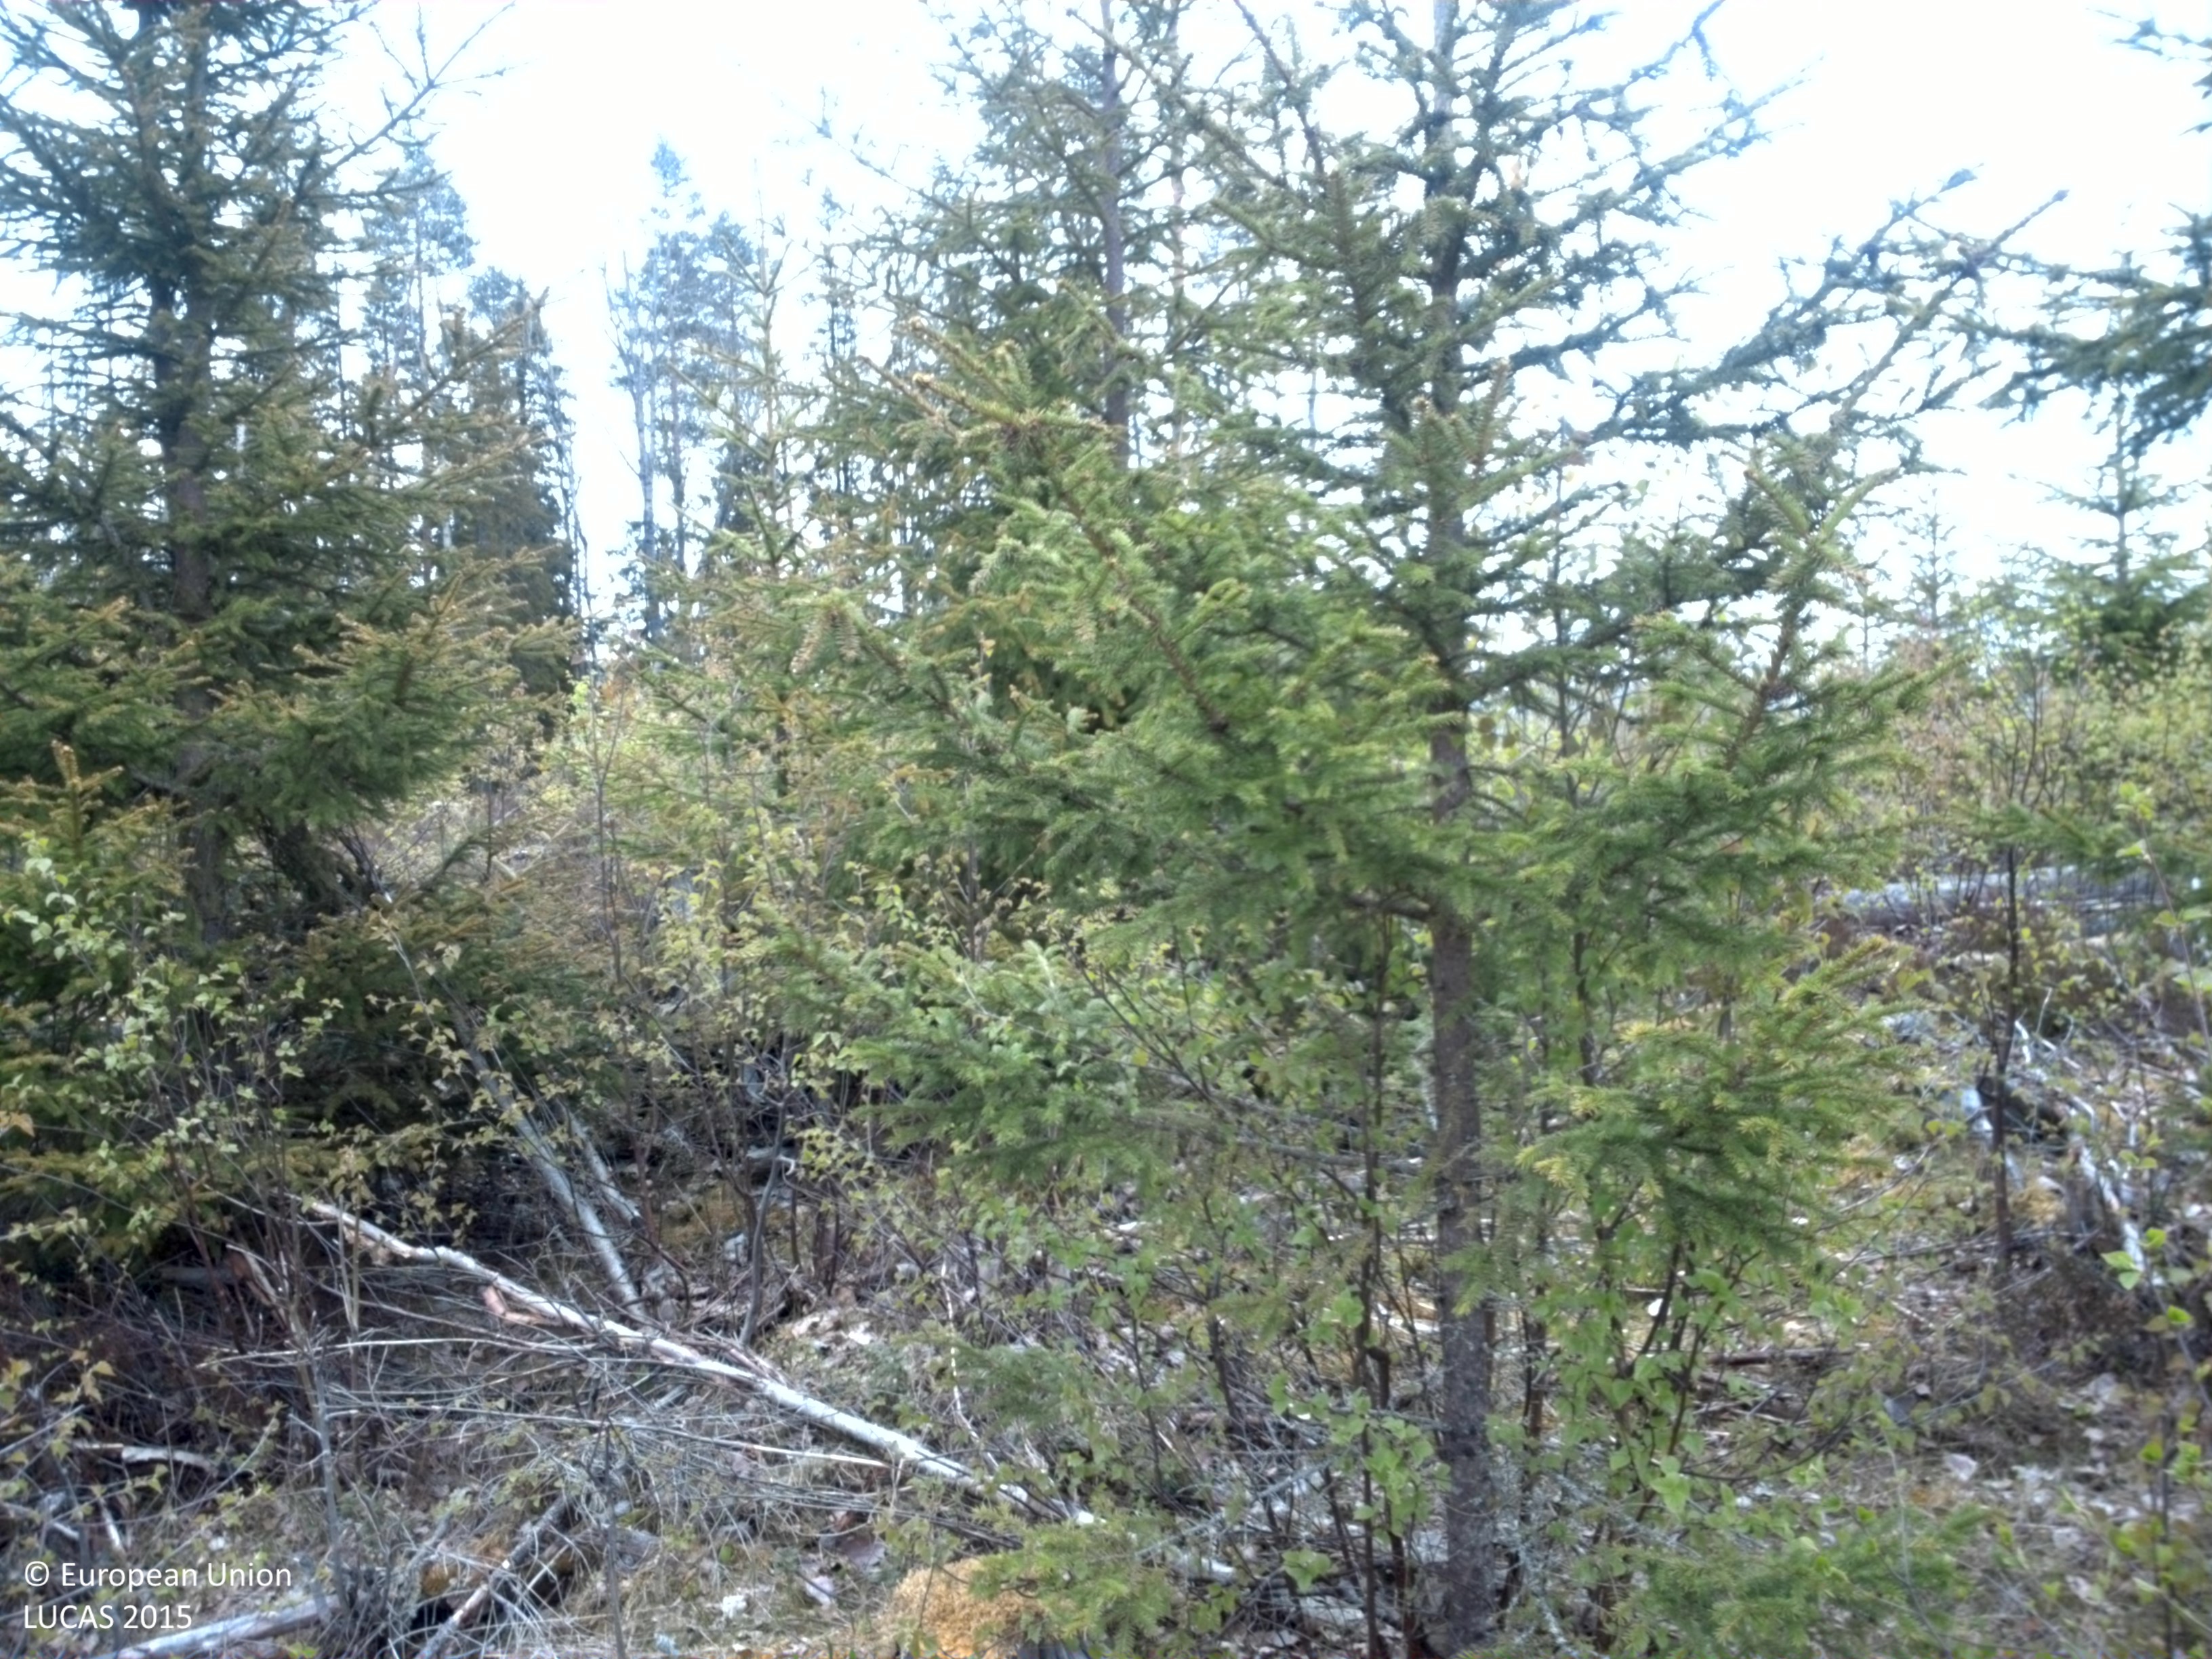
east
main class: Woodland
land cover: Spruce dominated mixed woodland
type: boreal forest
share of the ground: 50 - 75 %
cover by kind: coniferous forest trees 40 %, broadleaved forest trees 20 %, shrubs 20 %, herbaceous plants 20 %
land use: Forestry
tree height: < 5 m
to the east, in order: Spruce dominated mixed woodland; Spruce dominated coniferous woodland
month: May
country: SE
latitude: 60.9147
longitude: 12.5178
